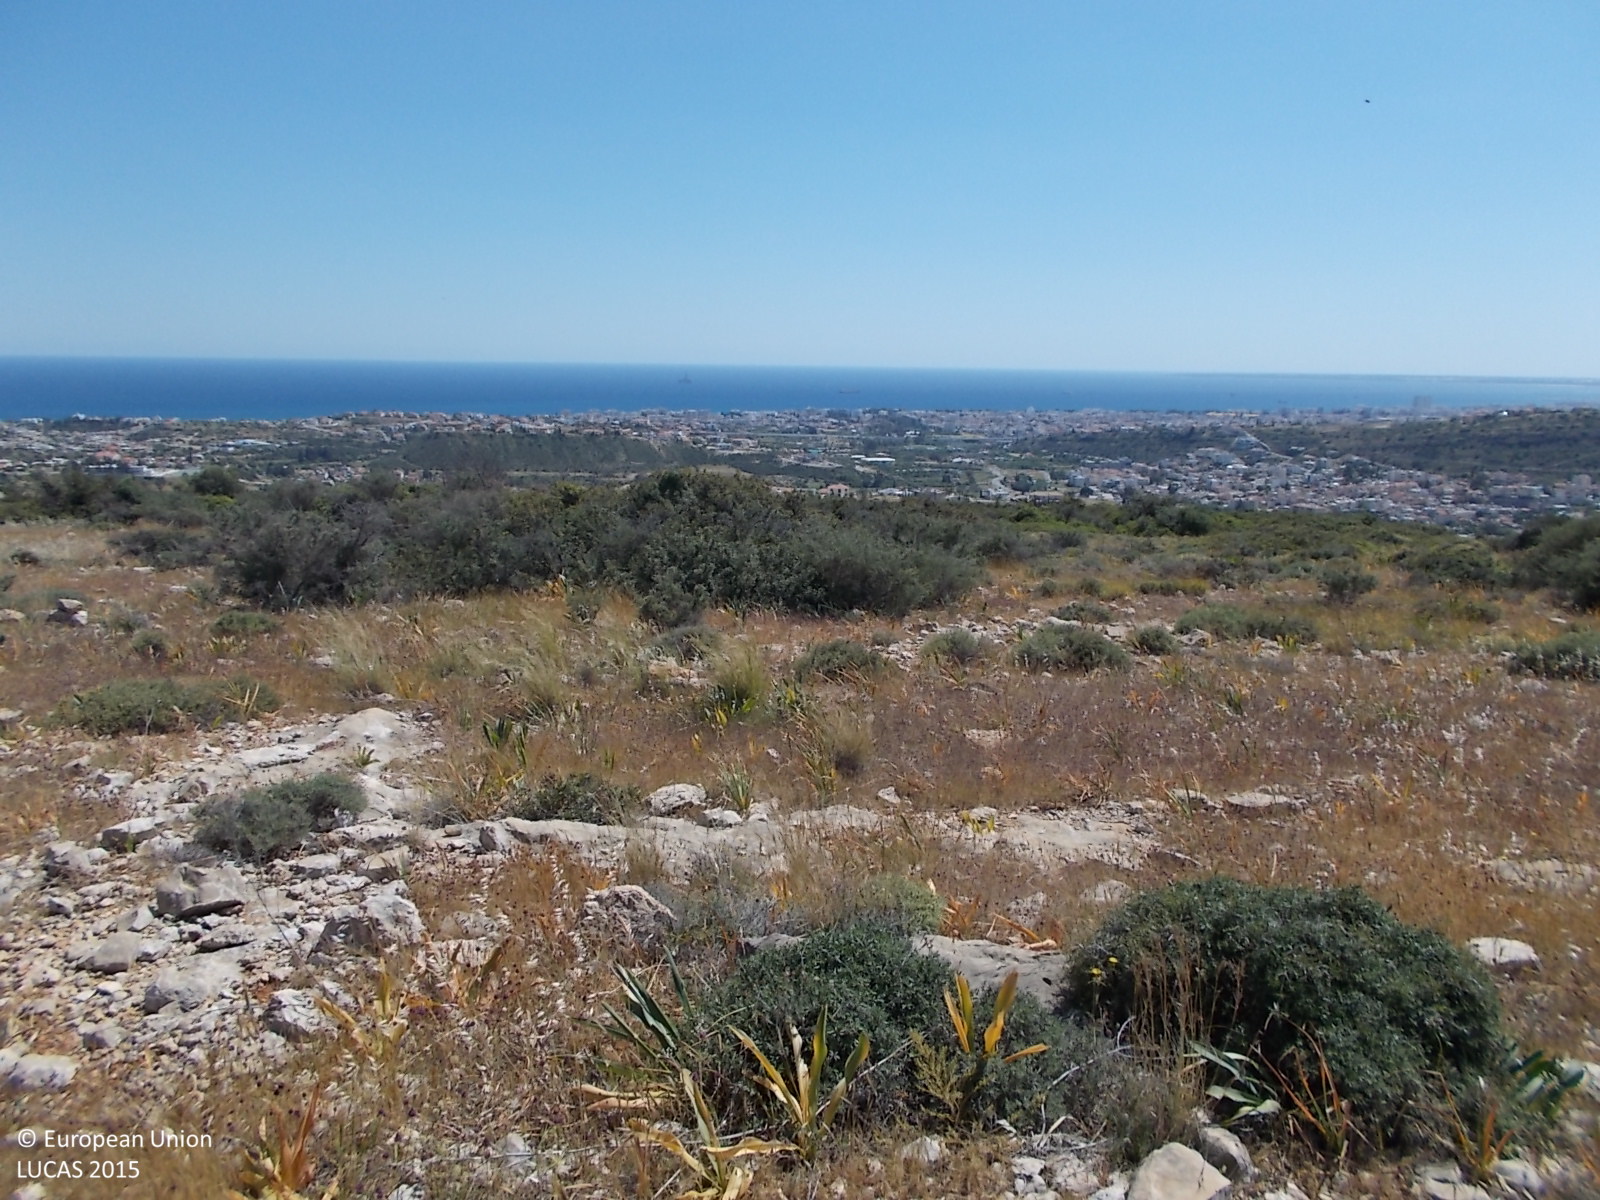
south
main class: Shrubland
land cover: Shrubland with sparse tree cover
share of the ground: 50 - 75 %
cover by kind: shrubs 65 %, herbaceous plants 20 %, broadleaved forest trees 5 %, consolidated bare surface 5 %, unconsolidated bare surface 5 %
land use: Semi-natural and natural areas not in use
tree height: < 5 m
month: April
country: CY
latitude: 34.7328
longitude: 33.0924
